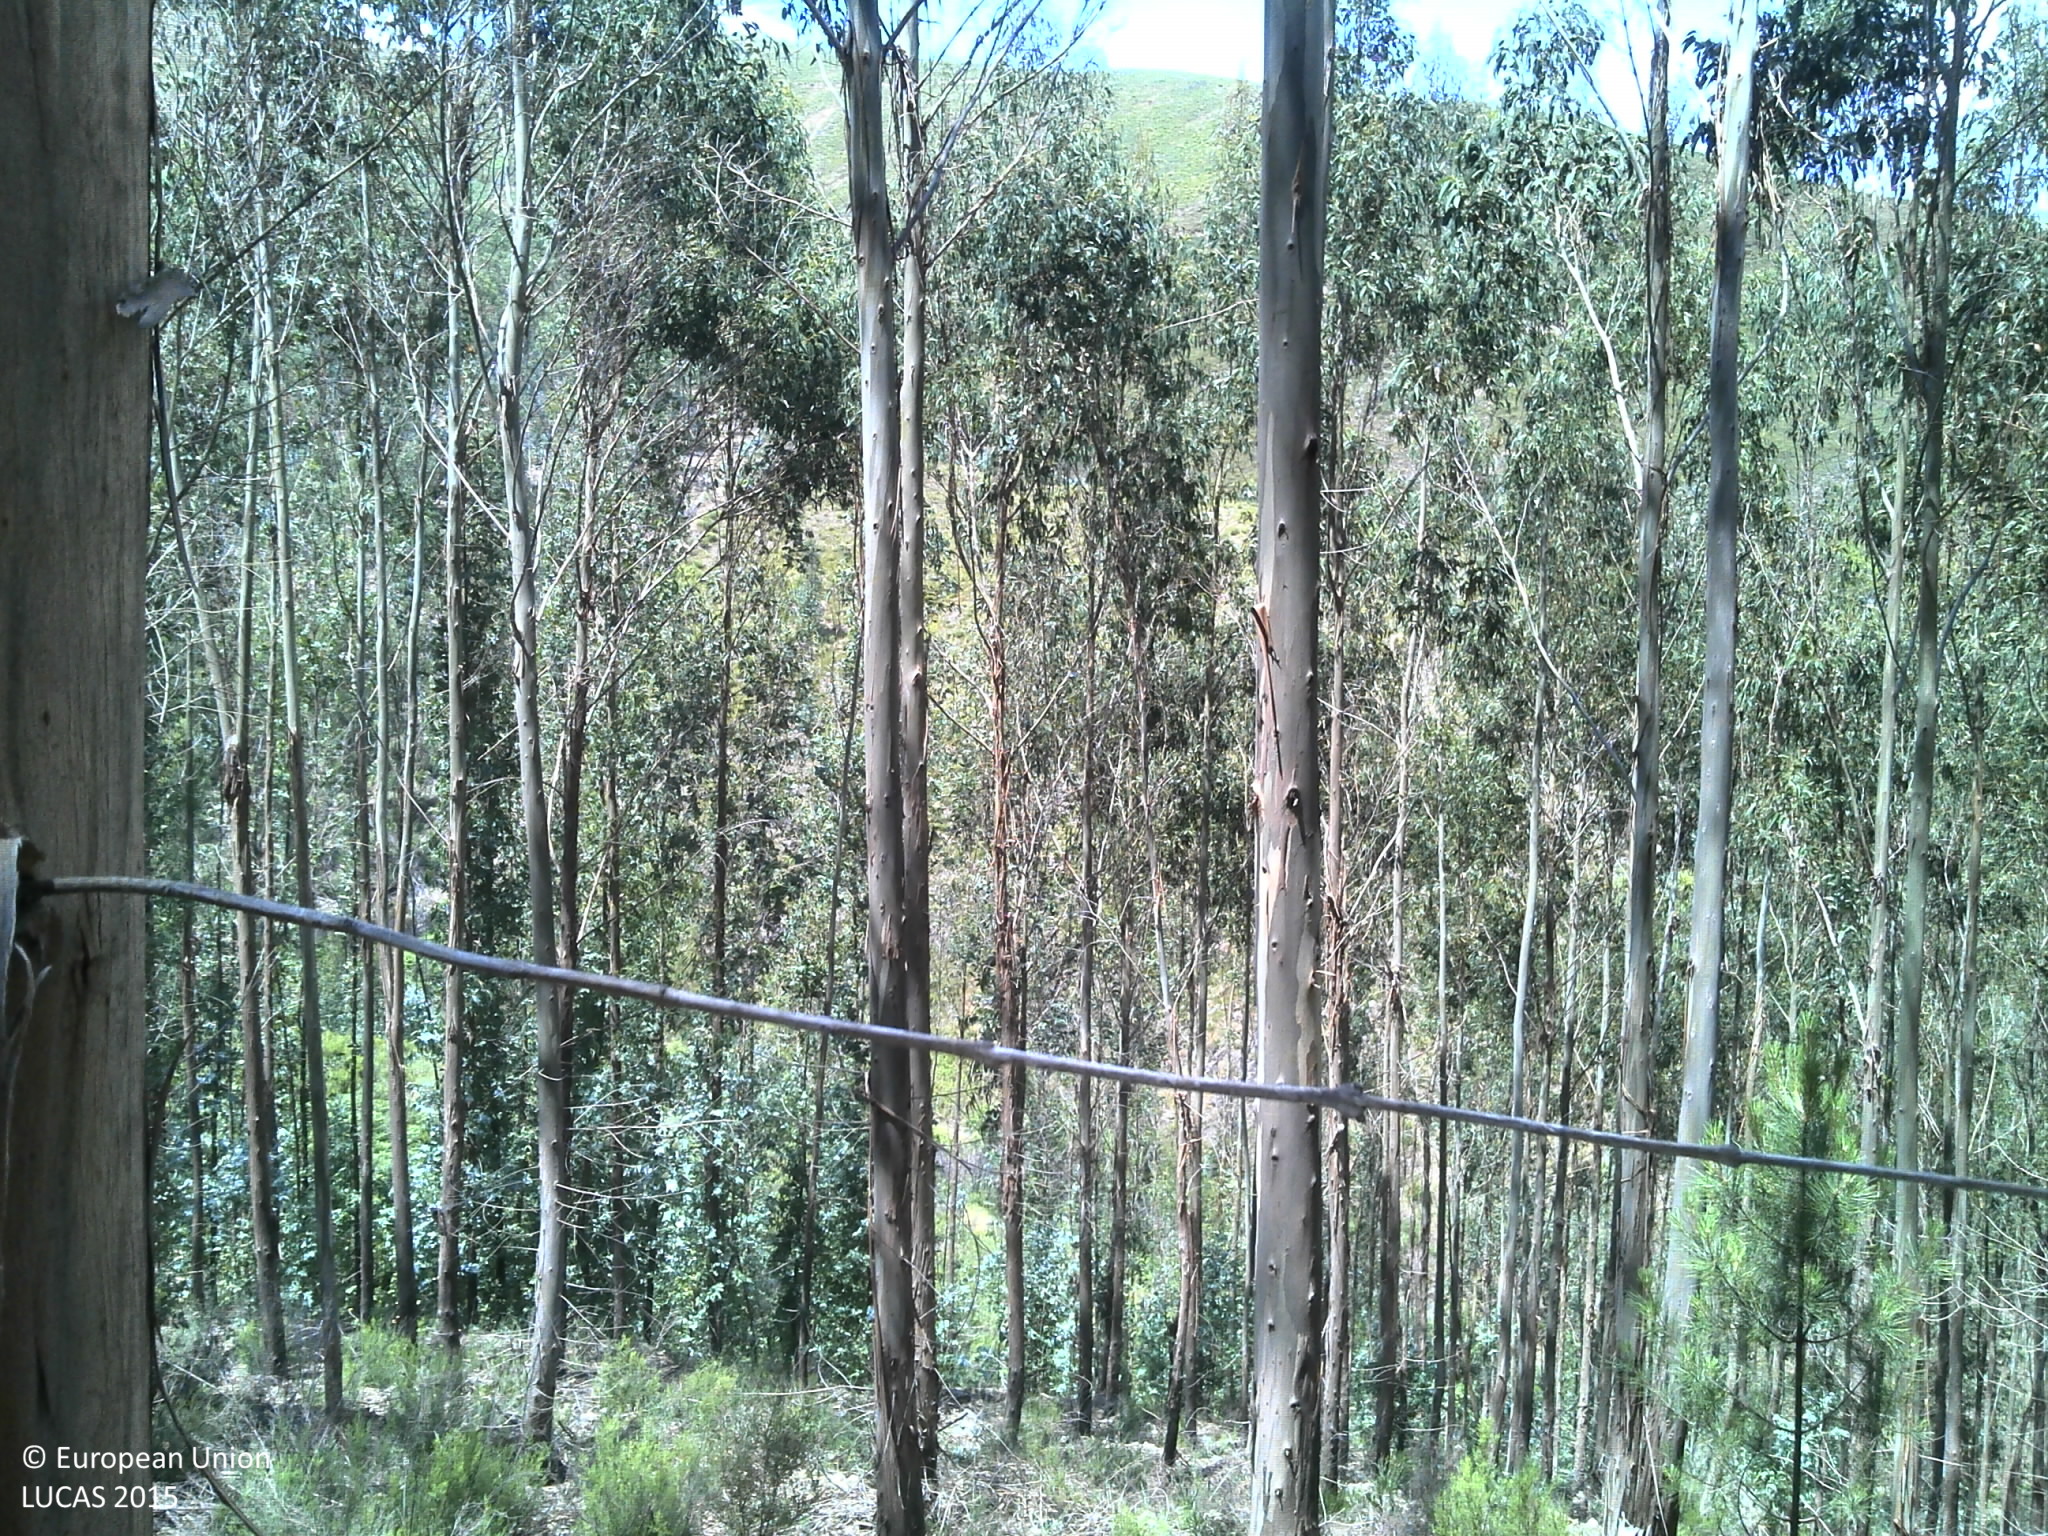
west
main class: Woodland
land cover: Broadleaved woodland
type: exotic forest
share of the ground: > 75 %
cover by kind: broadleaved forest trees 75 %, shrubs 15 %, unconsolidated bare surface 10 %
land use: Forestry
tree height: > 5 m
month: June
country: PT
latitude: 40.9194
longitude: -8.0749
